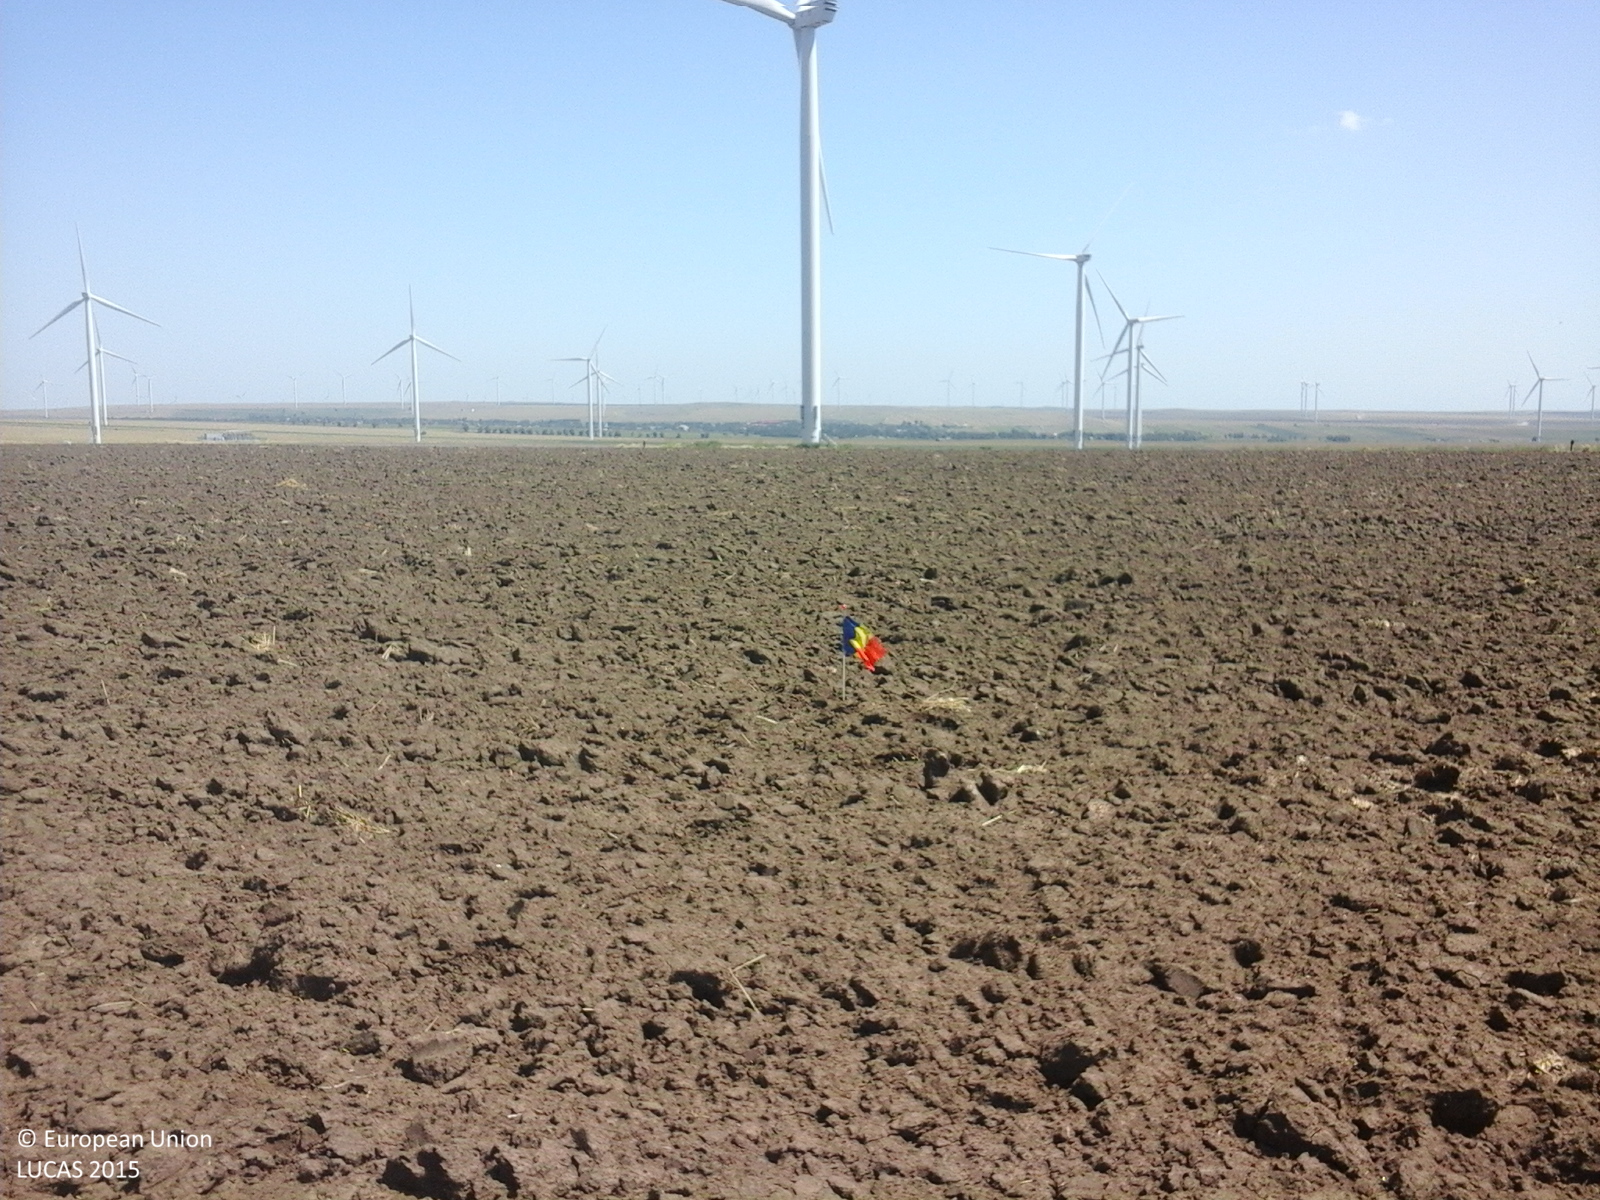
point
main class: Cropland
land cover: Common wheat
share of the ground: < 10 %
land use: Agriculture (excluding fallow land and kitchen gardens)
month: August
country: RO
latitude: 44.6022
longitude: 28.5328
